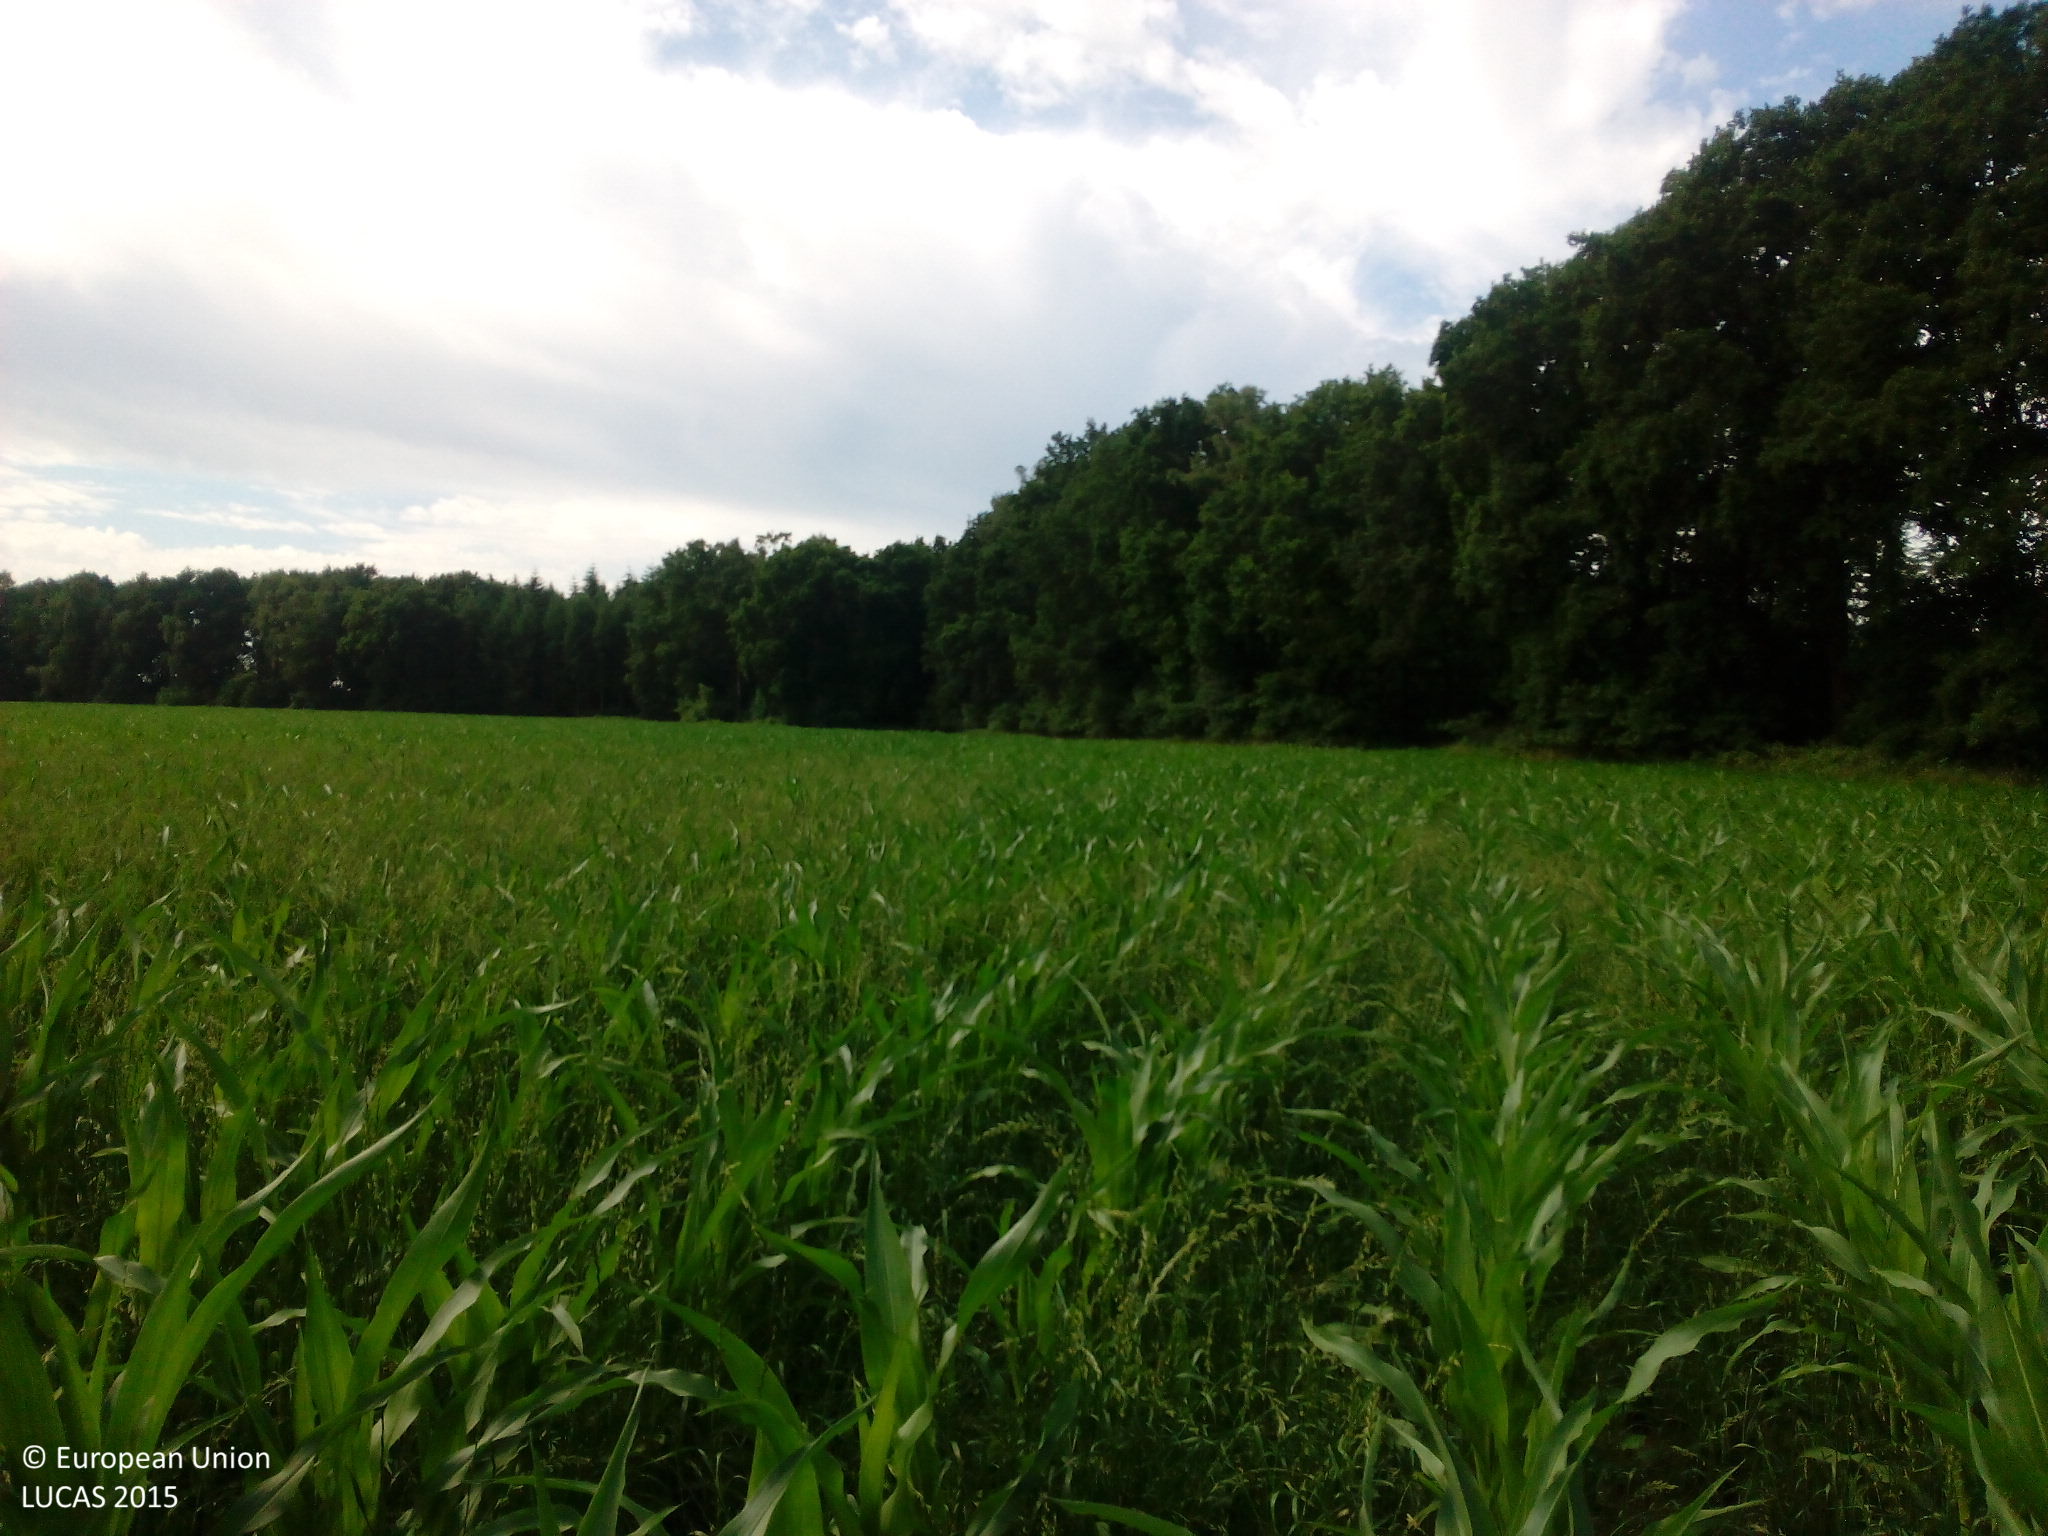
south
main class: Cropland
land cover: Maize
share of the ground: > 75 %
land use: Agriculture (excluding fallow land and kitchen gardens)
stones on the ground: < 10 %
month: July
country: DE
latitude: 52.7256
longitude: 7.3500
